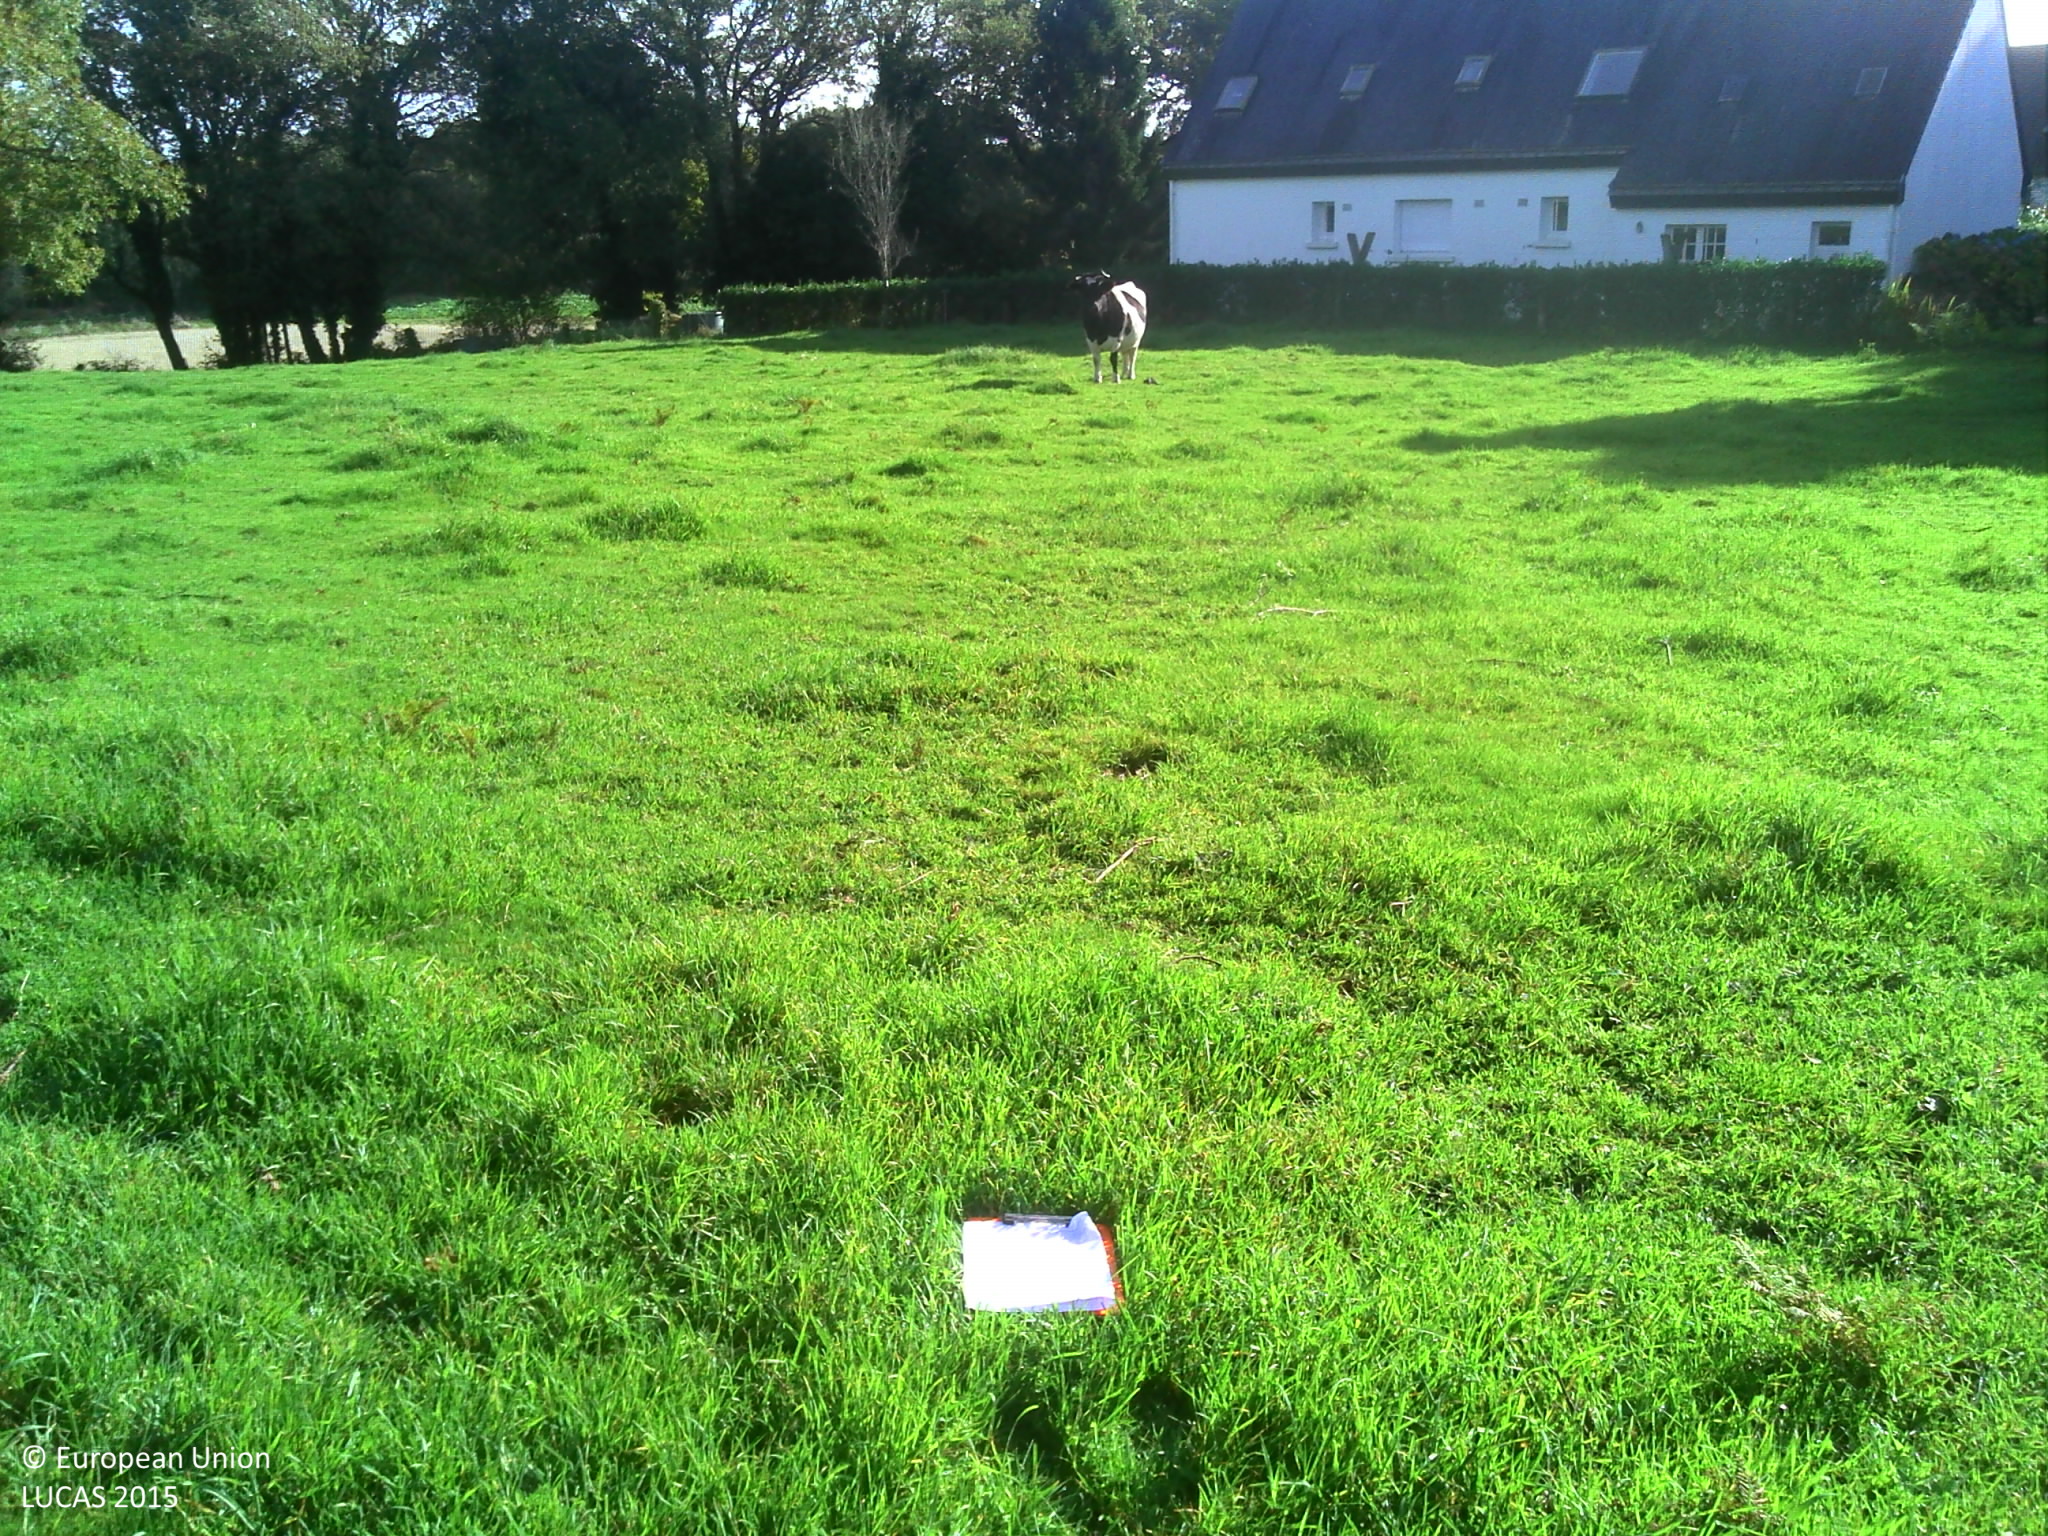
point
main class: Grassland
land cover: Grassland without tree/shrub cover
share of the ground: > 75 %
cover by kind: herbaceous plants 100 %
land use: Agriculture (excluding fallow land and kitchen gardens)
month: November
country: FR
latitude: 47.6240
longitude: -3.0673
